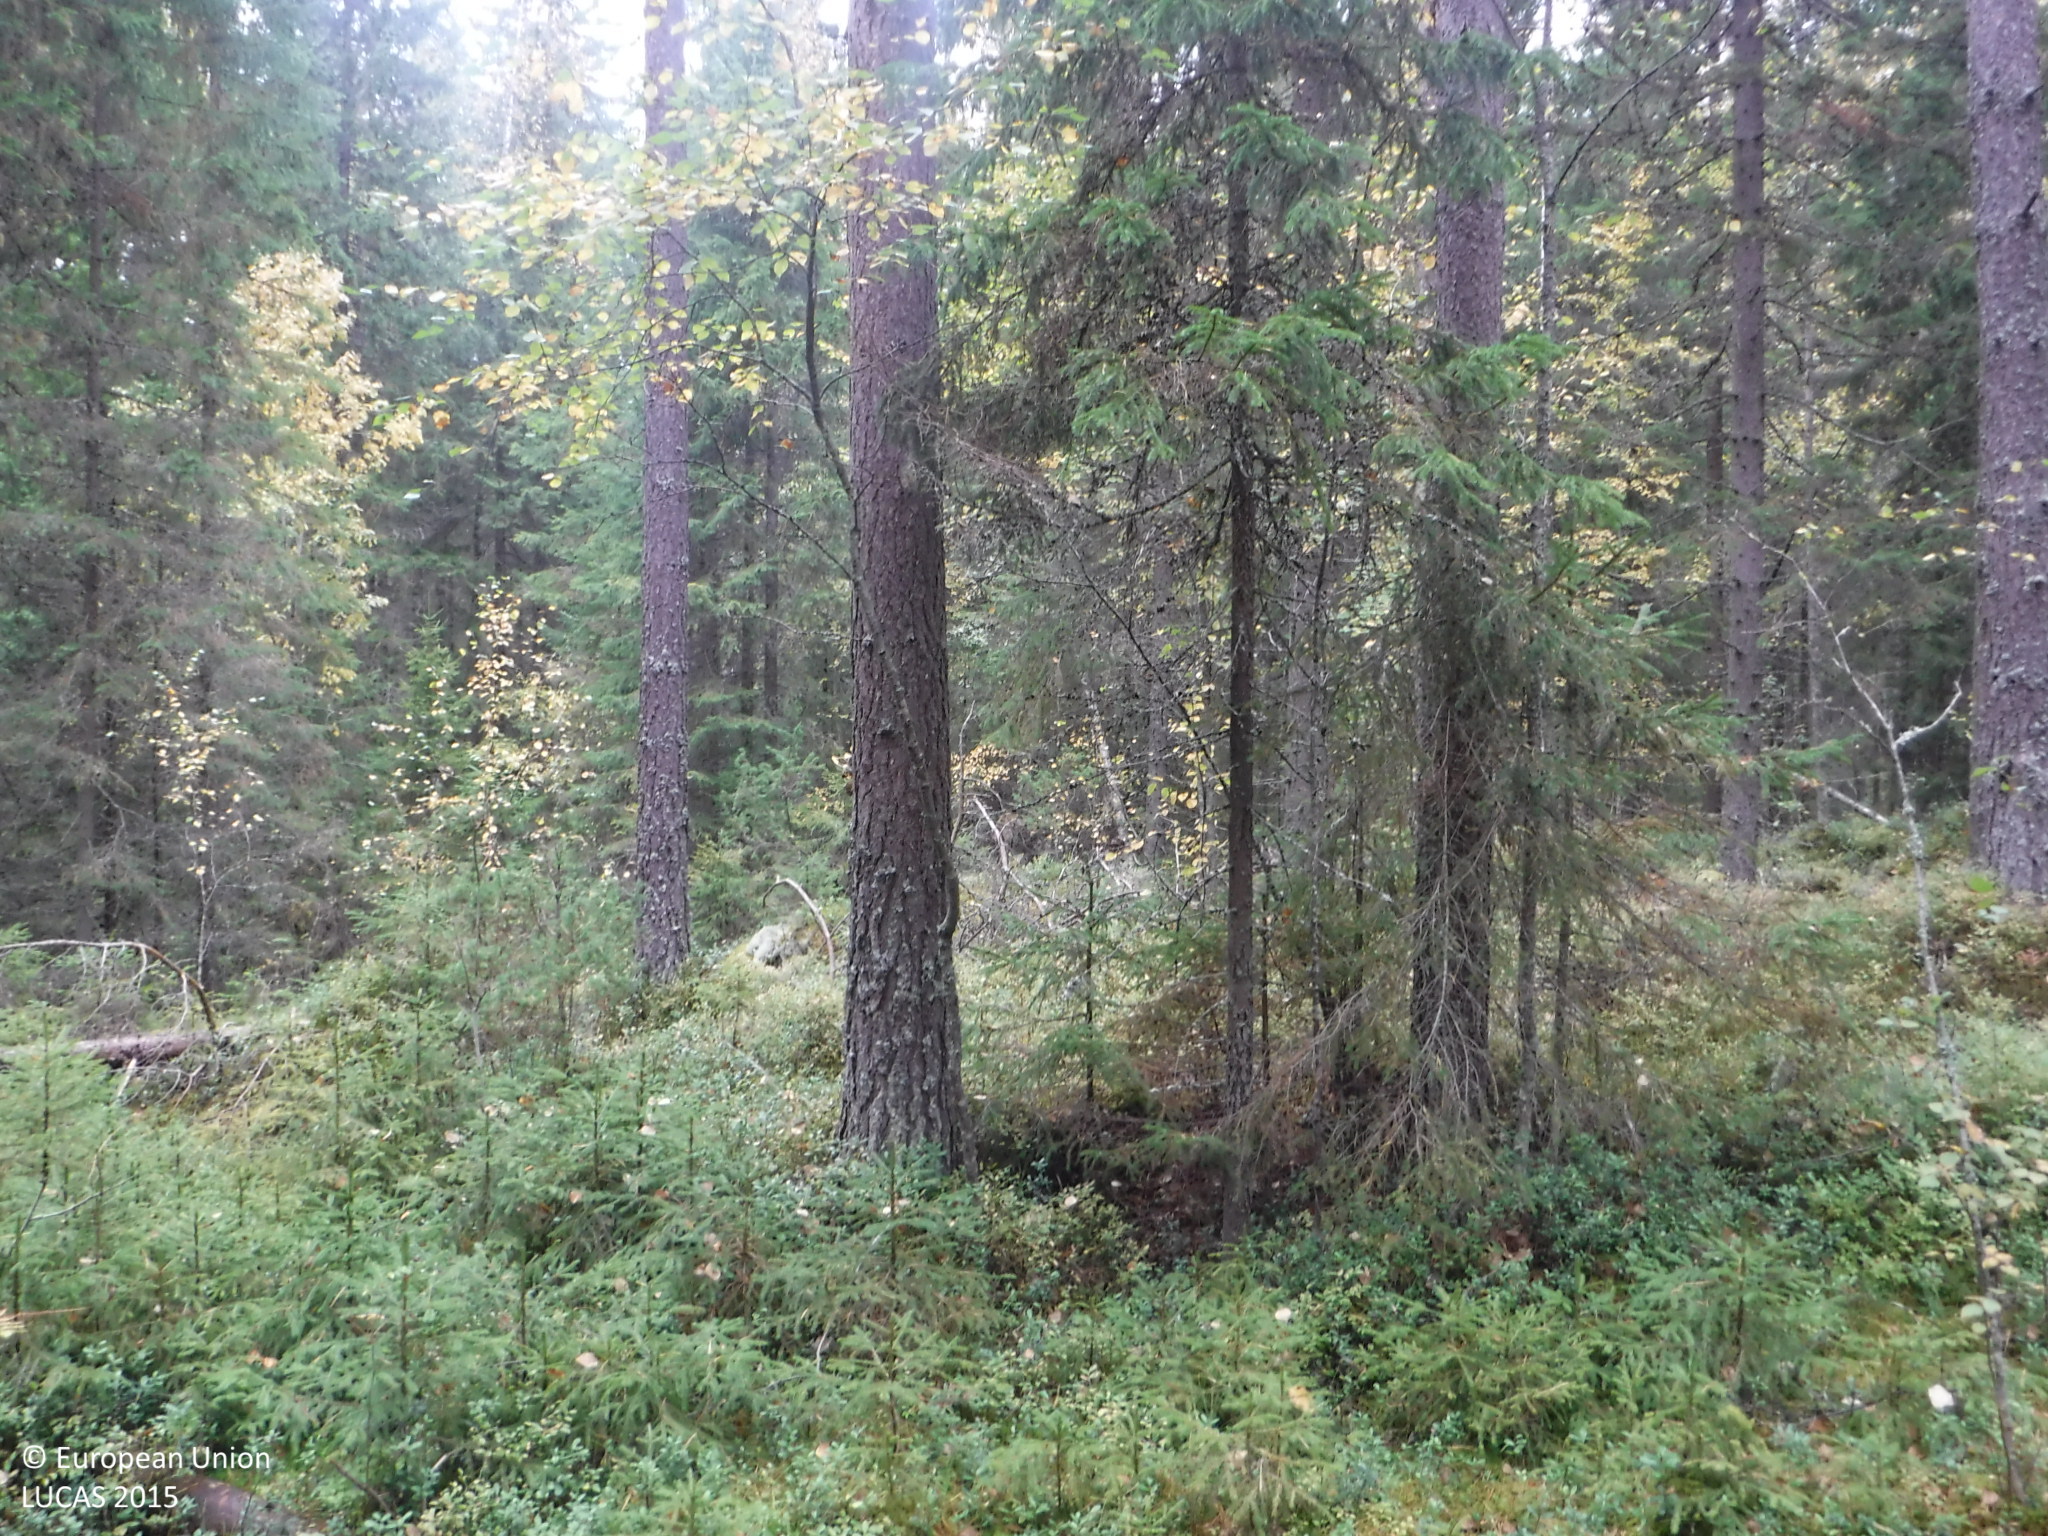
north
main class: Woodland
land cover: Other coniferous woodland
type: boreal forest
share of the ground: 50 - 75 %
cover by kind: coniferous forest trees 45 %, shrubs 25 %, lichens and mosses 25 %, broadleaved forest trees 5 %
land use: Forestry
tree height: > 5 m
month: September
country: FI
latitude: 61.7509
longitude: 24.2002
